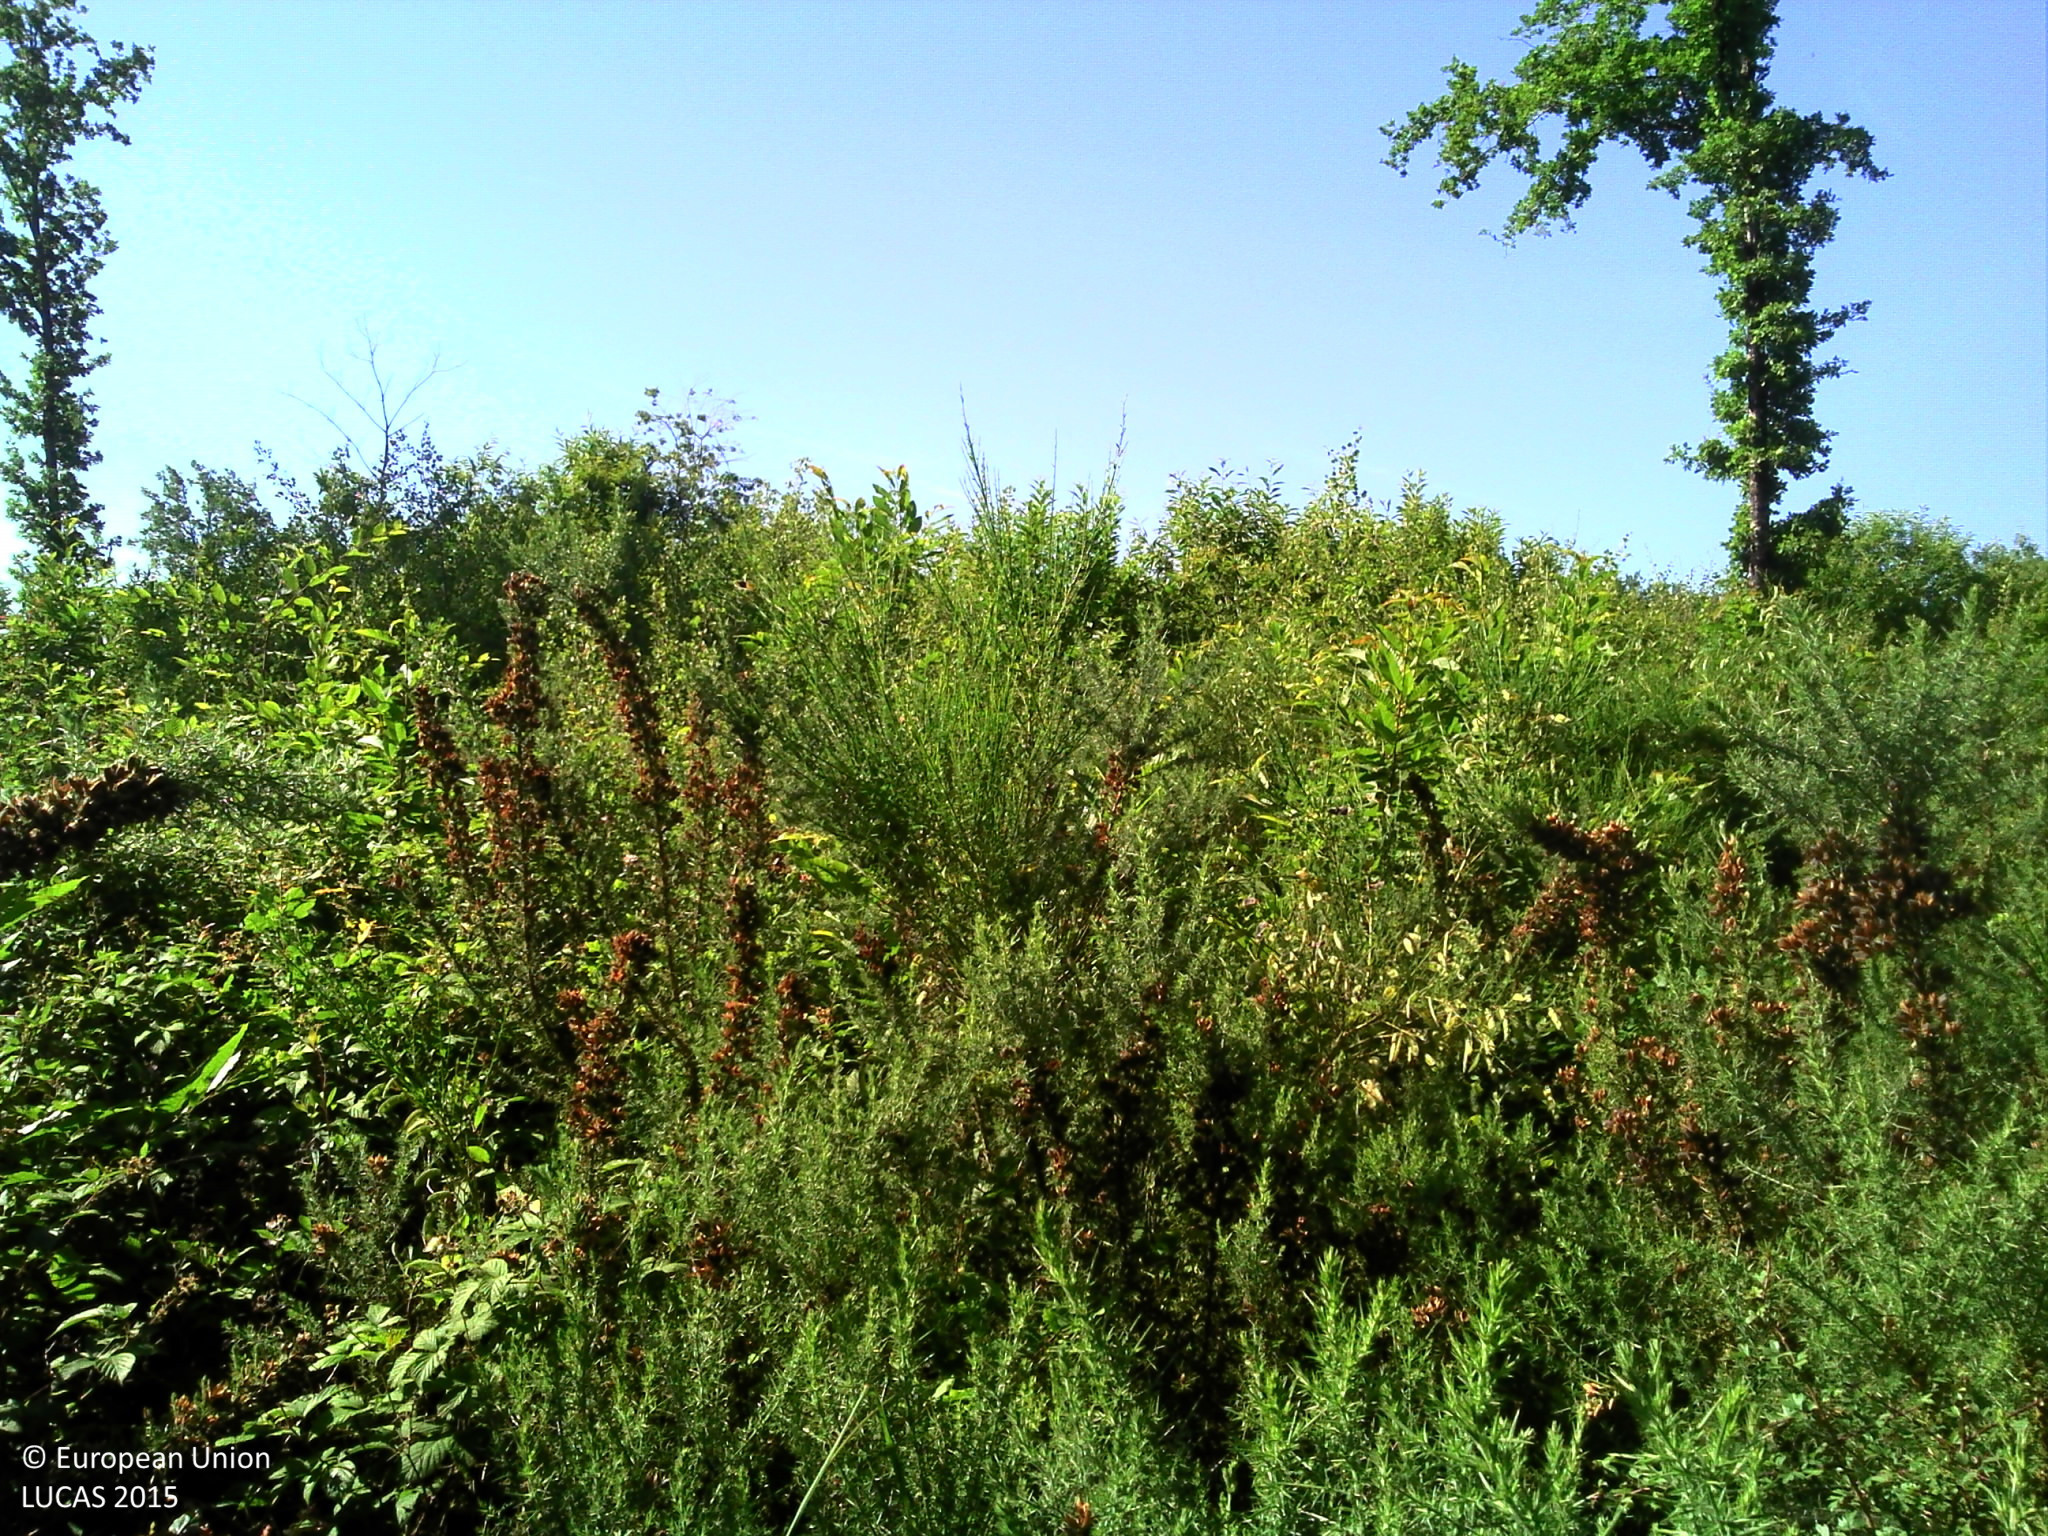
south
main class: Woodland
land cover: Broadleaved woodland
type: thermophilous deciduous forest
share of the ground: > 75 %
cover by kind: shrubs 45 %, broadleaved forest trees 35 %, herbaceous plants 15 %, lichens and mosses 5 %
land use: Semi-natural and natural areas not in use
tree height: > 5 m
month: June
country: FR
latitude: 45.8654
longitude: 0.4139
